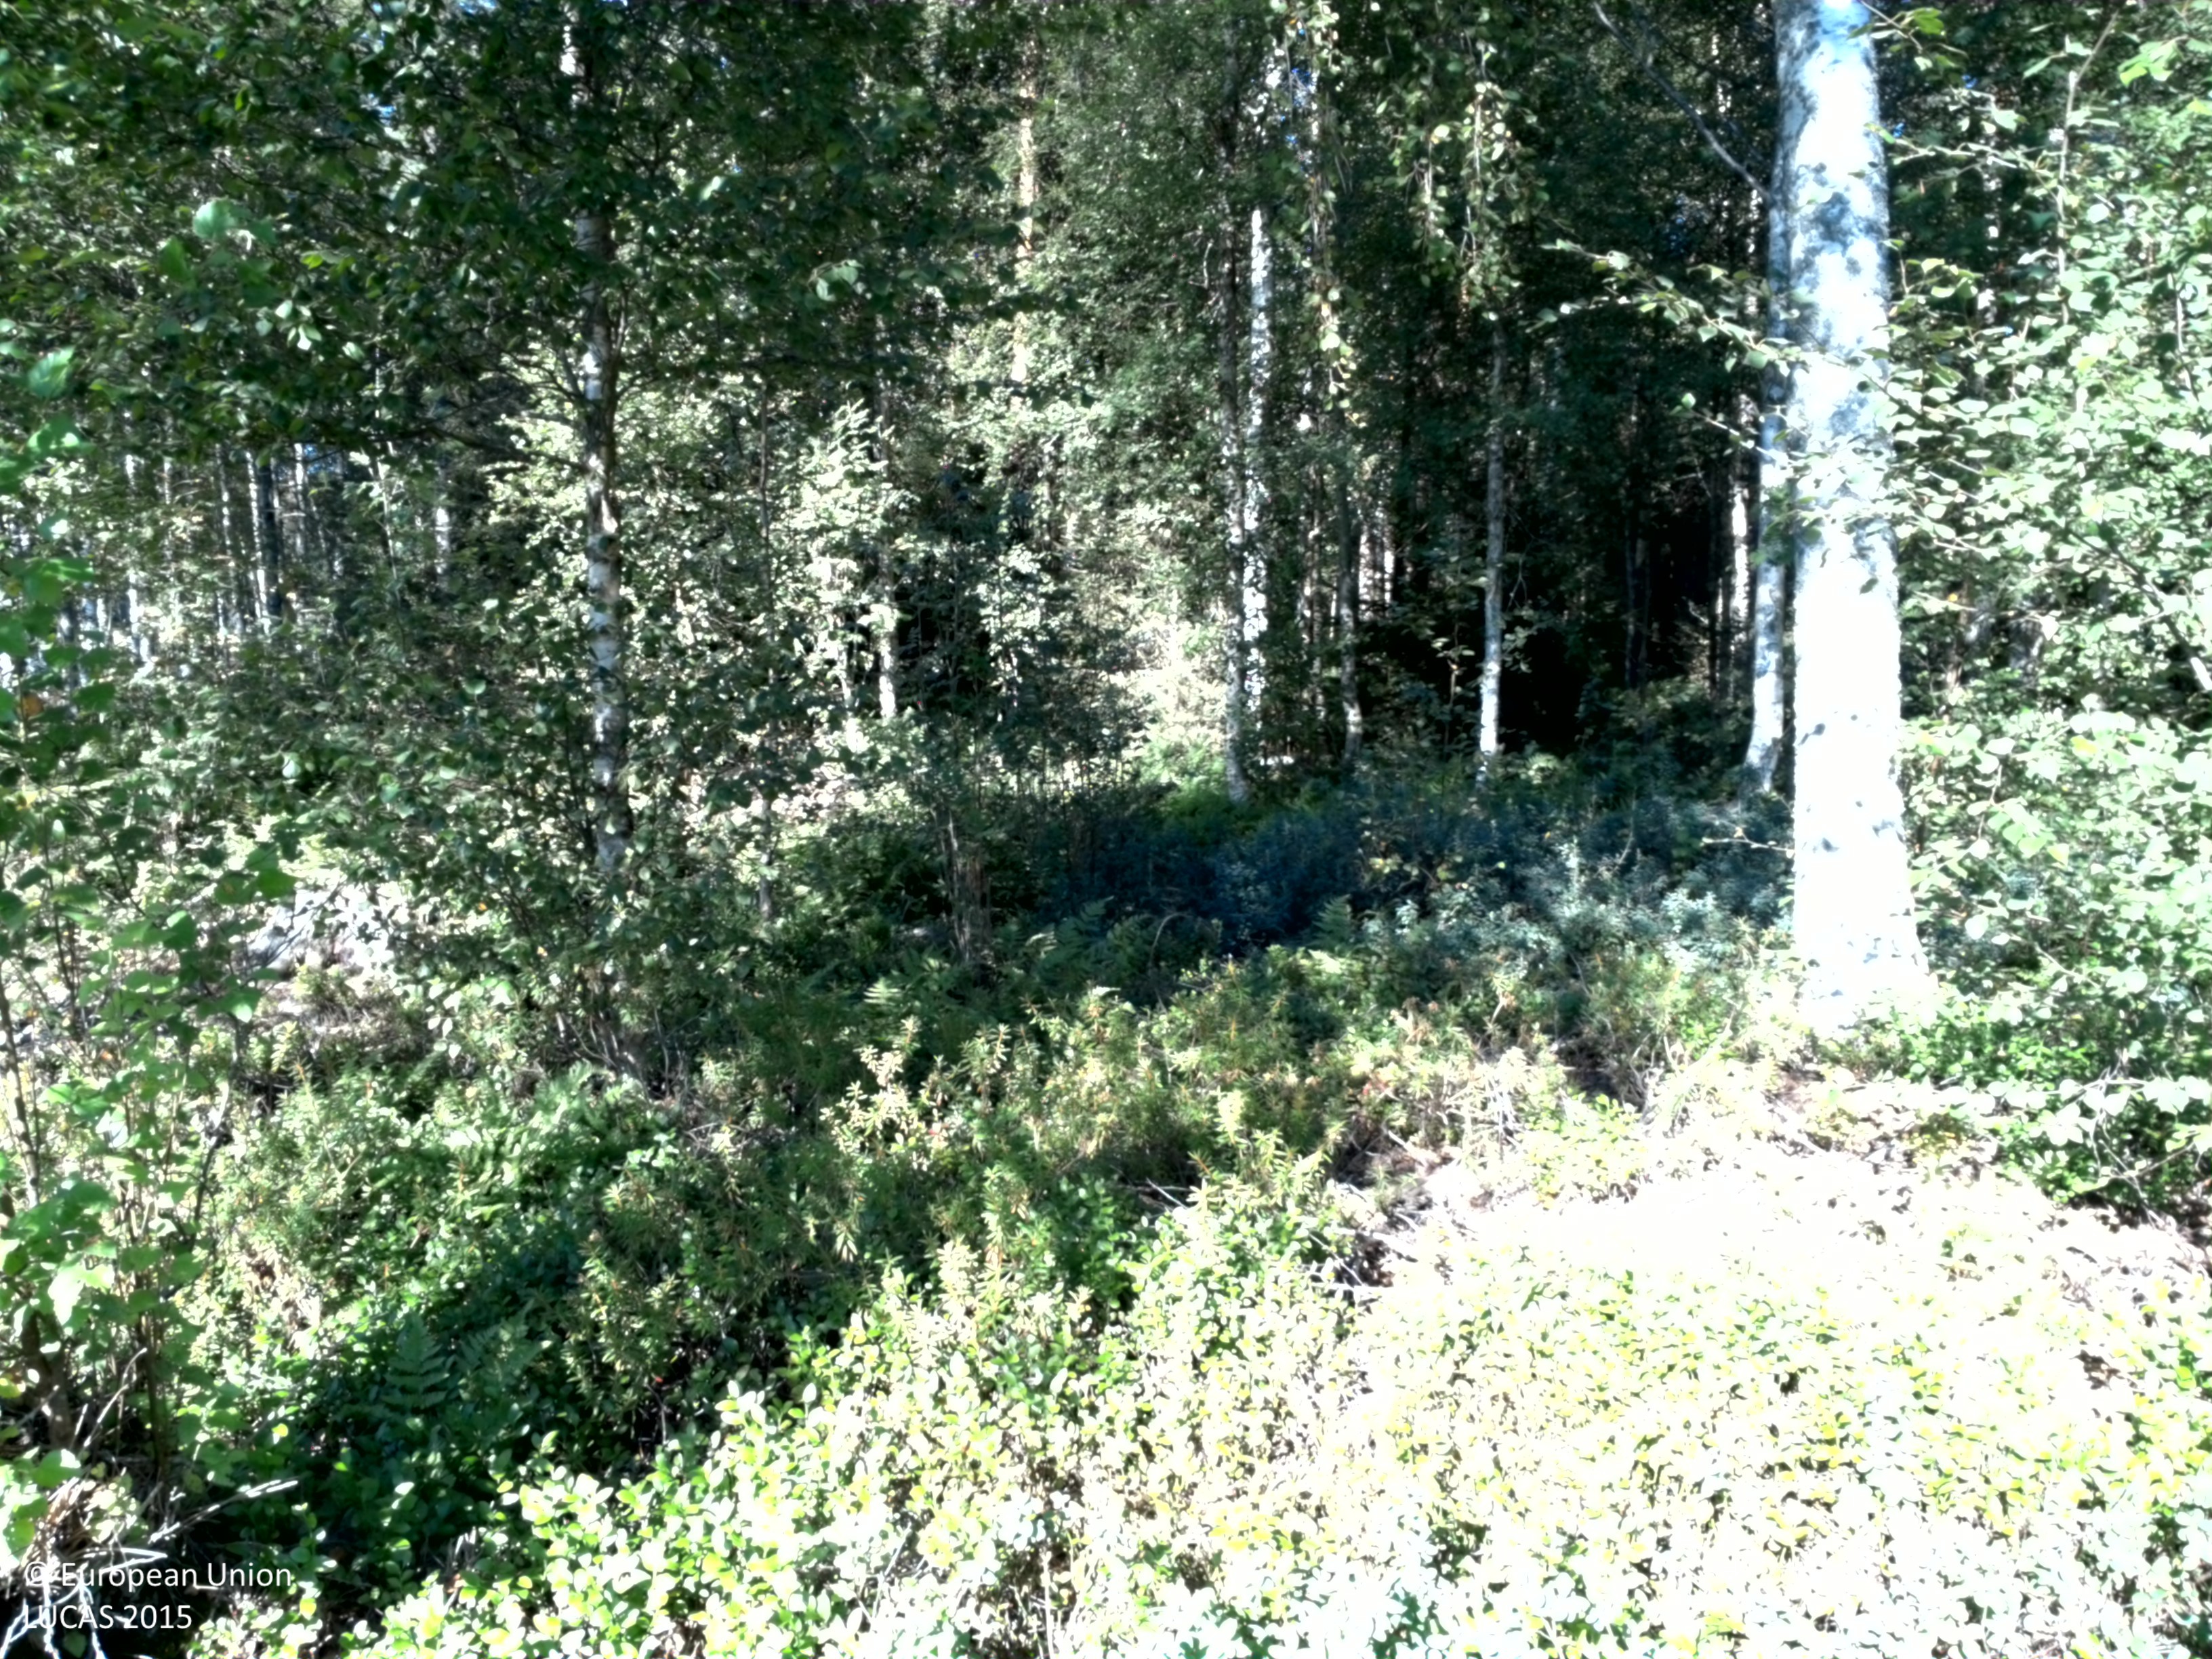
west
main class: Woodland
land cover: Broadleaved woodland
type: hemiboreal forest and nemoral coniferous forest and mixed broadleaved-coniferous forest
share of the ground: > 75 %
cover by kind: broadleaved forest trees 80 %, shrubs 15 %, coniferous forest trees 5 %
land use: Forestry
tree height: > 5 m
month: August
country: SE
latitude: 60.0621
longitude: 16.9793
